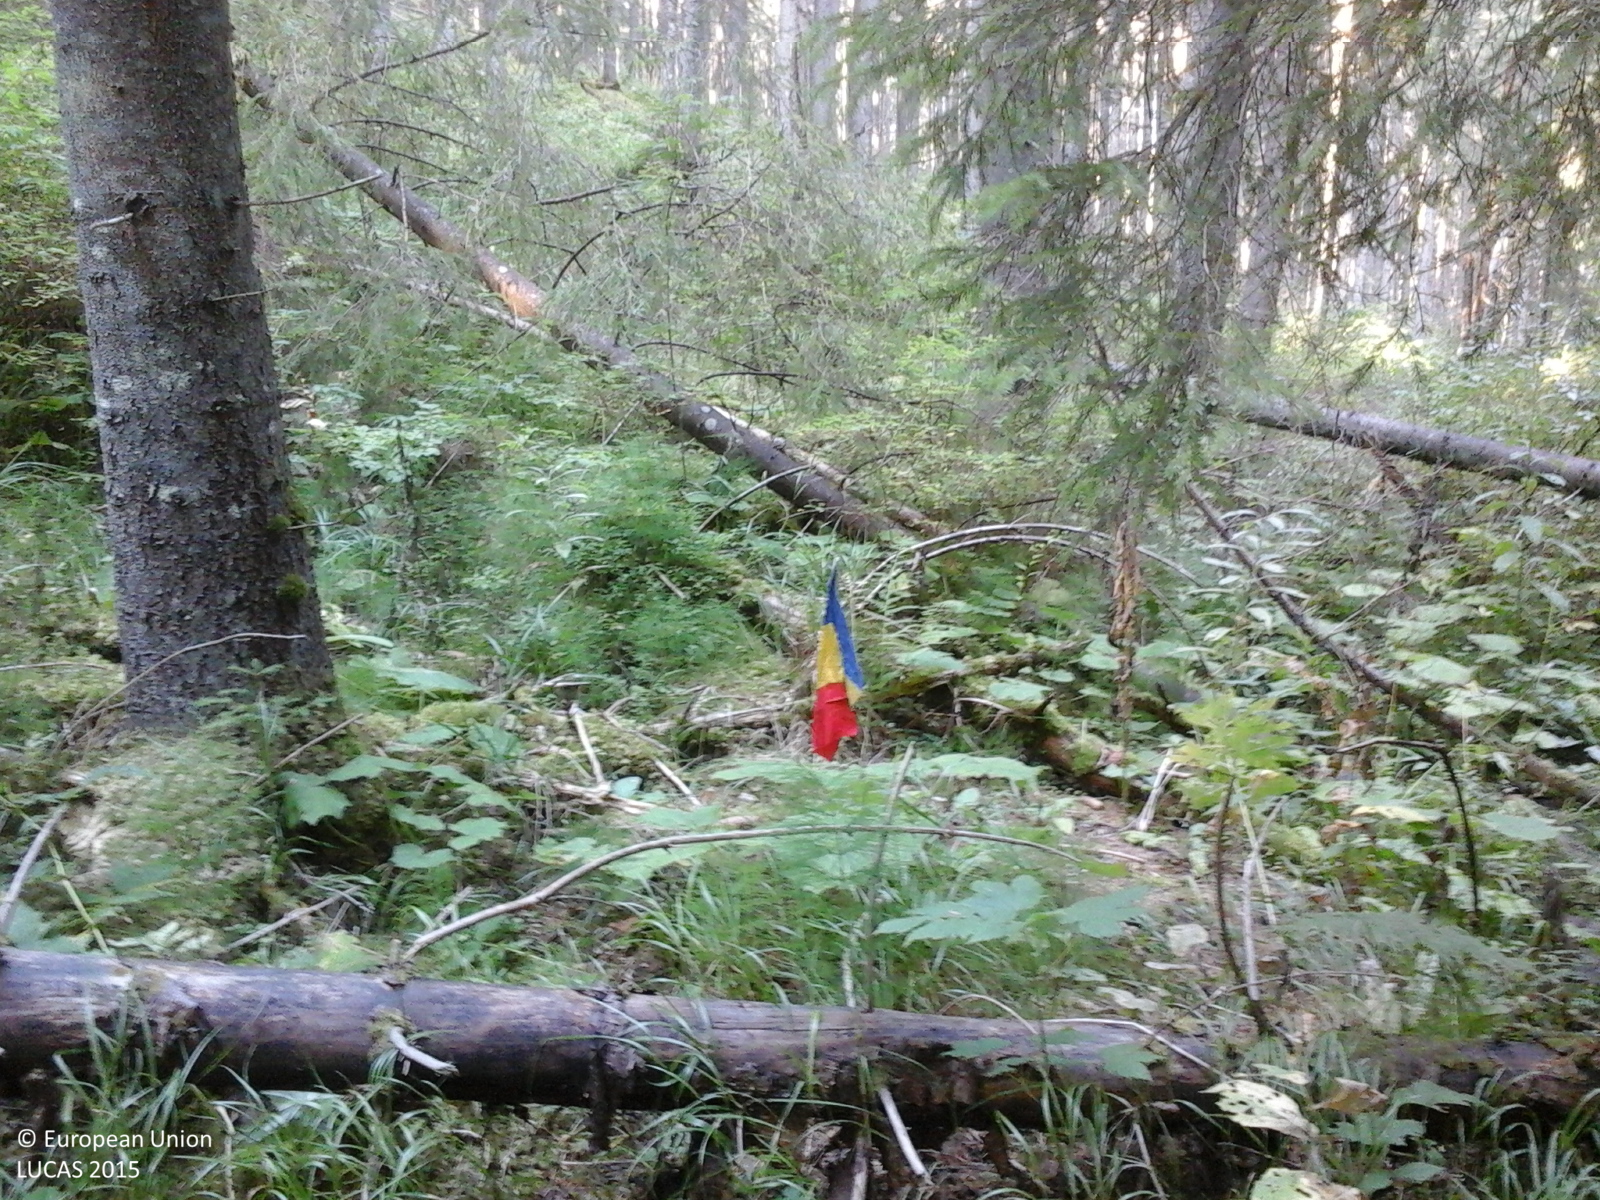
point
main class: Woodland
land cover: Spruce dominated coniferous woodland
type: alpine coniferous forest
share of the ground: > 75 %
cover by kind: coniferous forest trees 100 %
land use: Forestry
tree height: > 5 m
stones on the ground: < 10 %
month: September
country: RO
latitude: 47.2487
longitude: 25.1011
